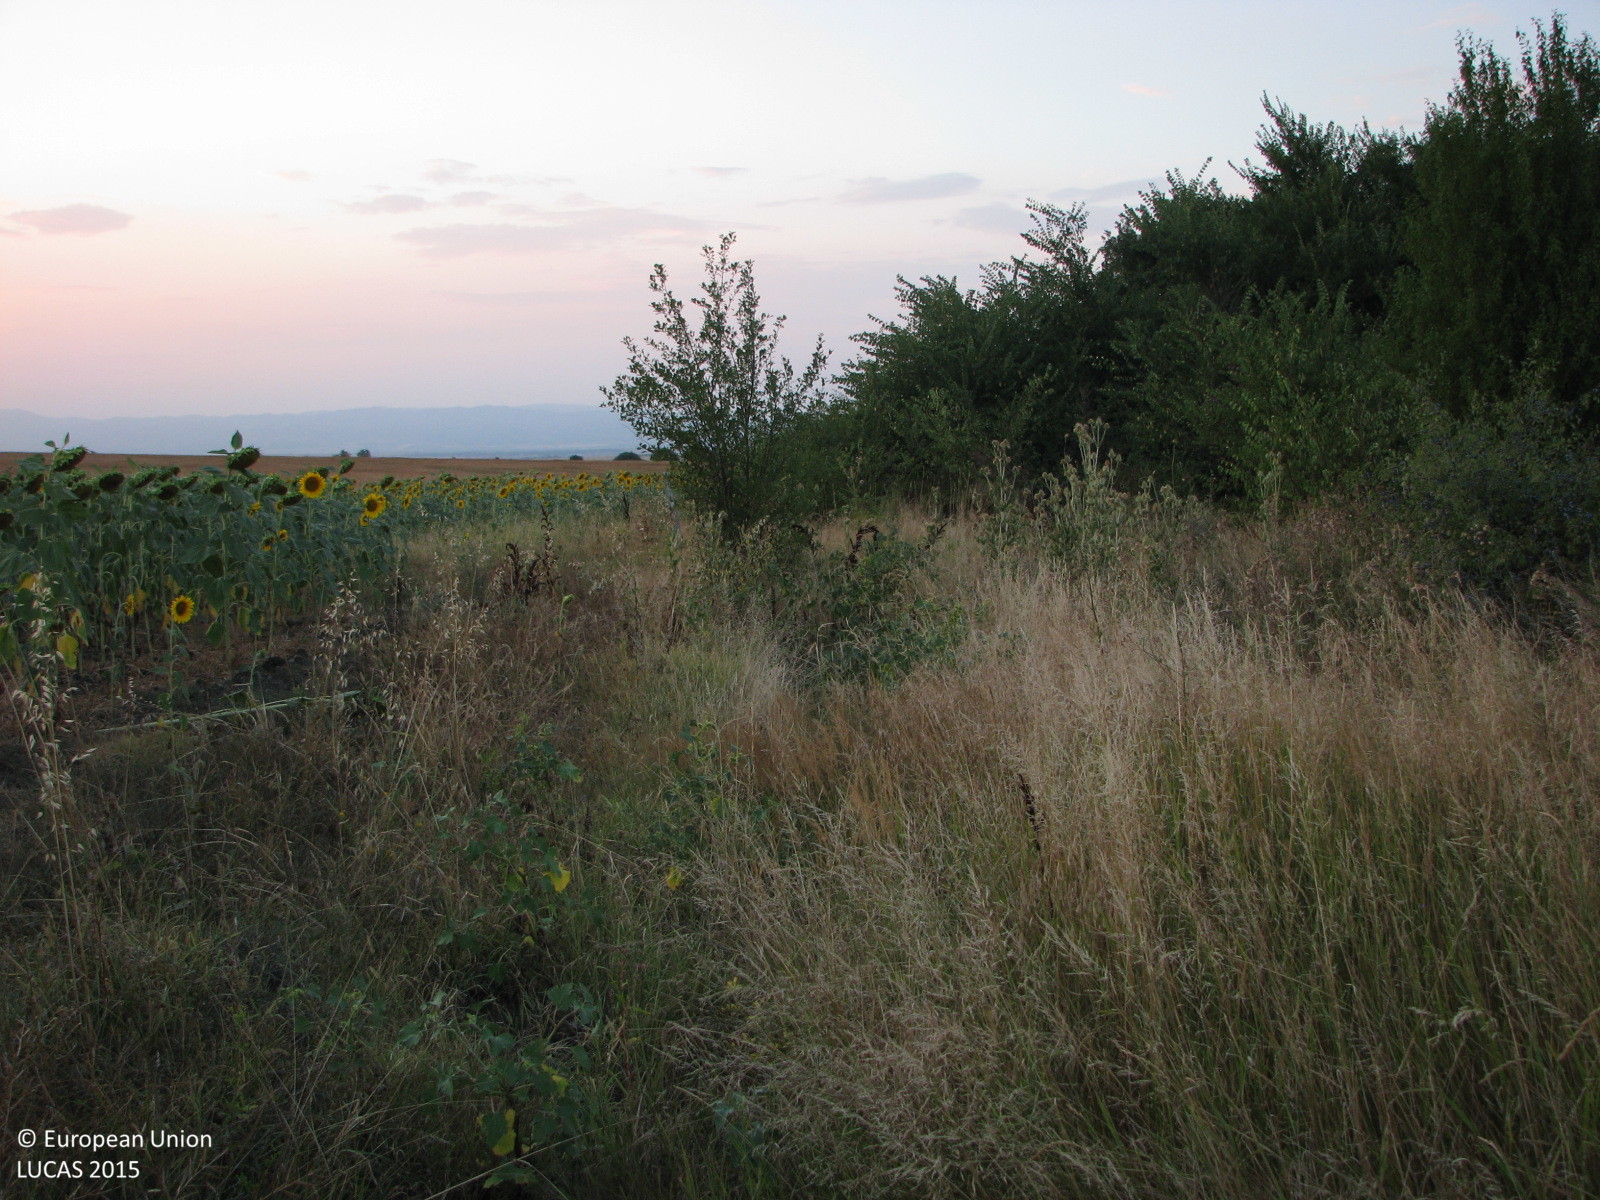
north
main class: Grassland
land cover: Grassland with sparse tree/shrub cover
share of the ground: > 75 %
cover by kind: herbaceous plants 90 %, broadleaved forest trees 5 %, shrubs 5 %
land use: Semi-natural and natural areas not in use
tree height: > 5 m
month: August
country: BG
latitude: 42.4786
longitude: 26.6514
